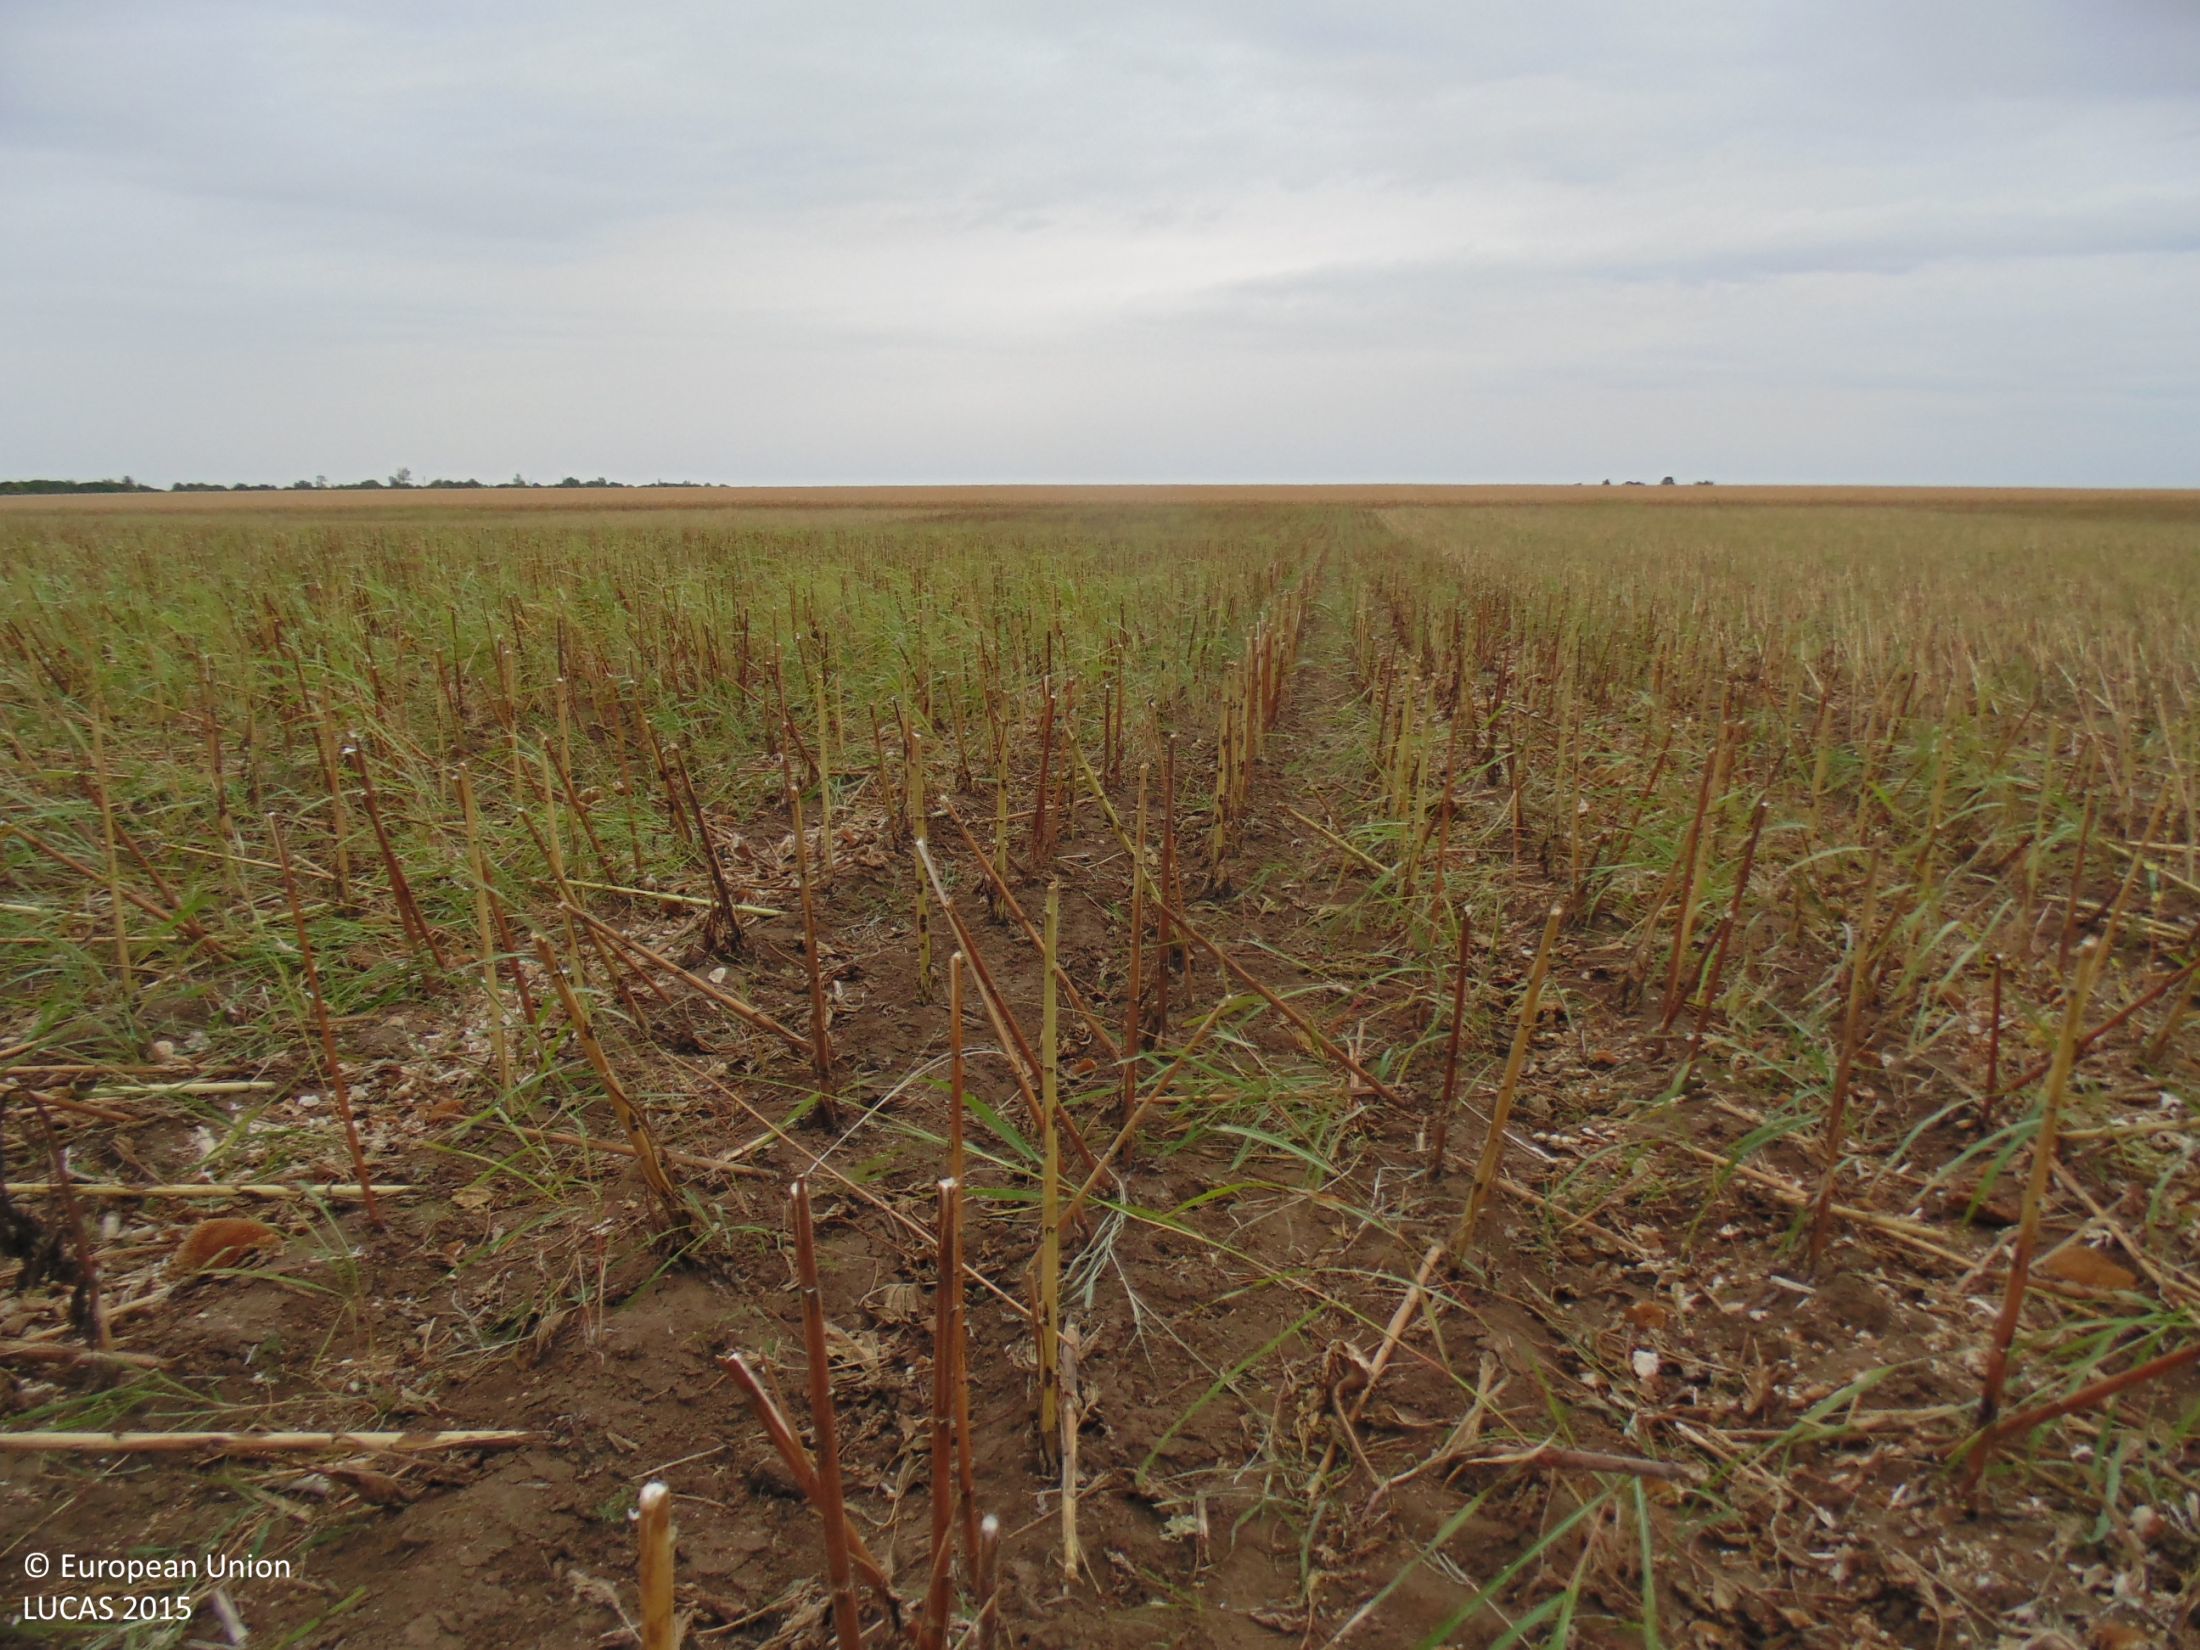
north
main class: Cropland
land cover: Sunflower
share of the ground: 10 - 25 %
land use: Agriculture (excluding fallow land and kitchen gardens)
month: September
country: BG
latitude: 44.0232
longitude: 26.8752
